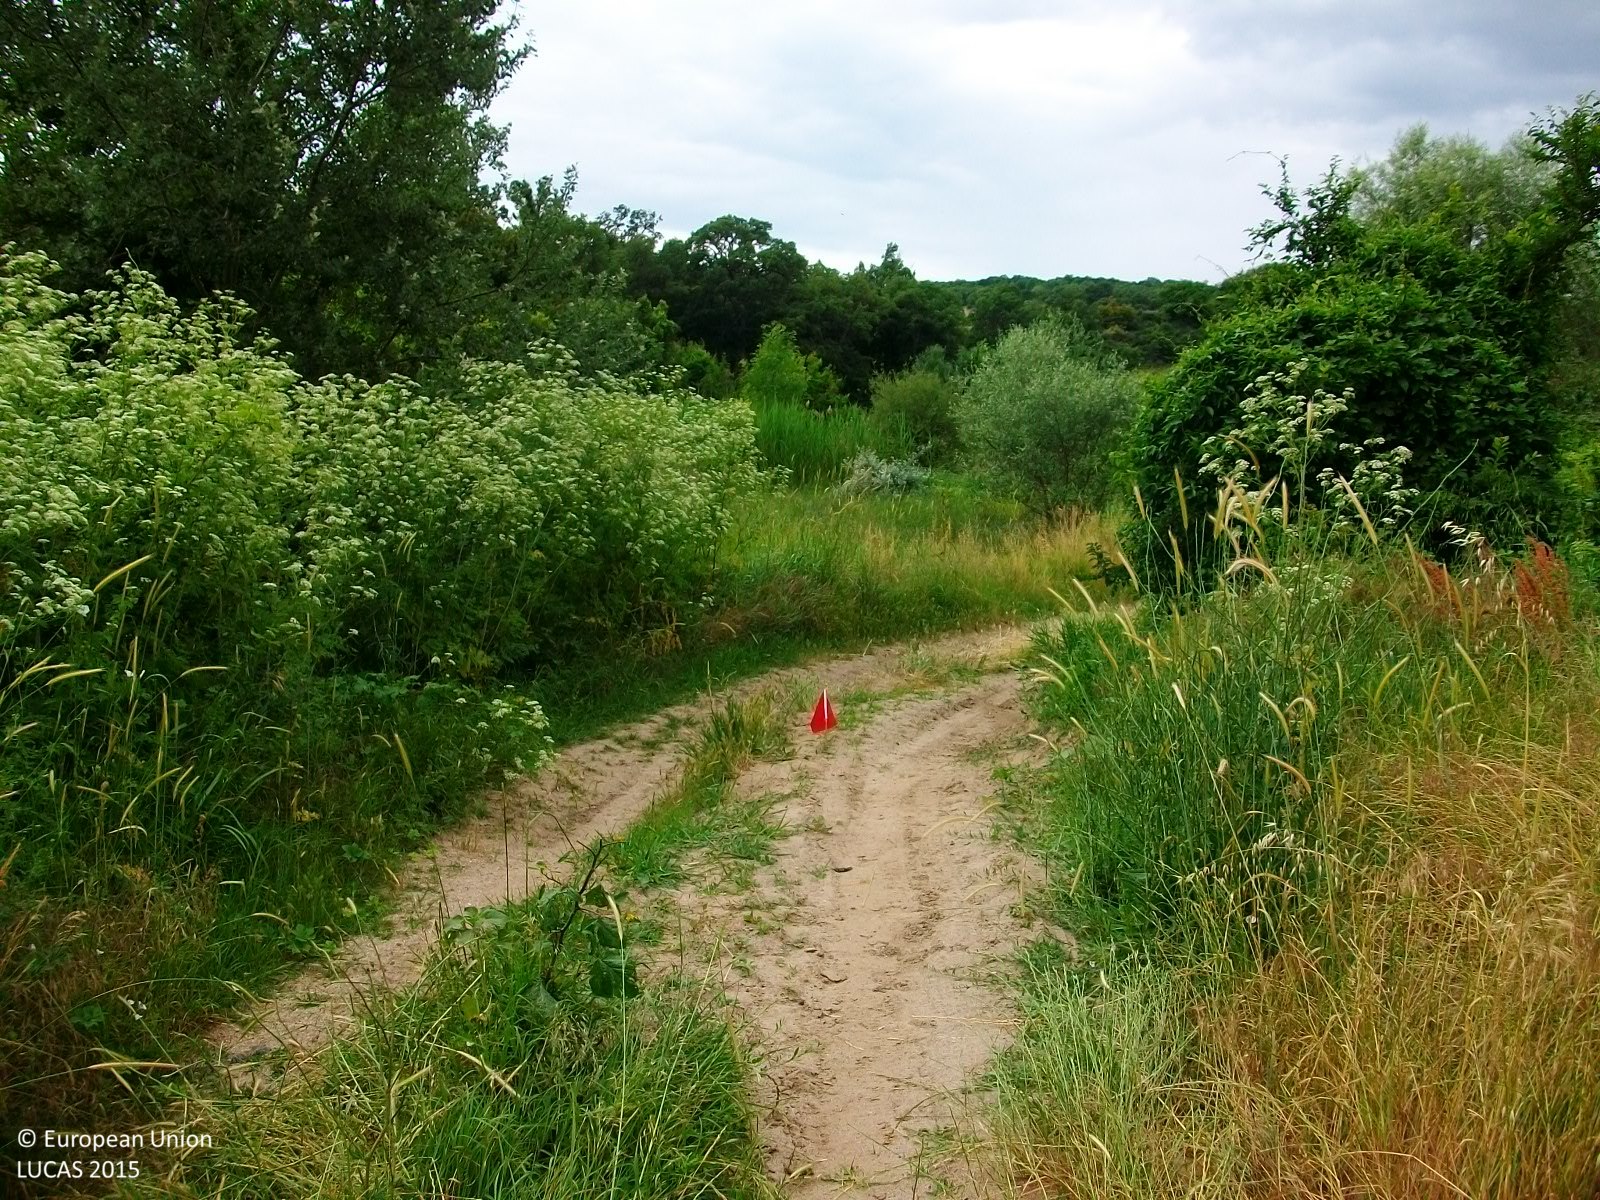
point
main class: Cropland
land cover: Sunflower
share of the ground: < 10 %
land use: Agriculture (excluding fallow land and kitchen gardens)
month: June
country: GR
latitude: 41.6814
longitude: 26.1346
